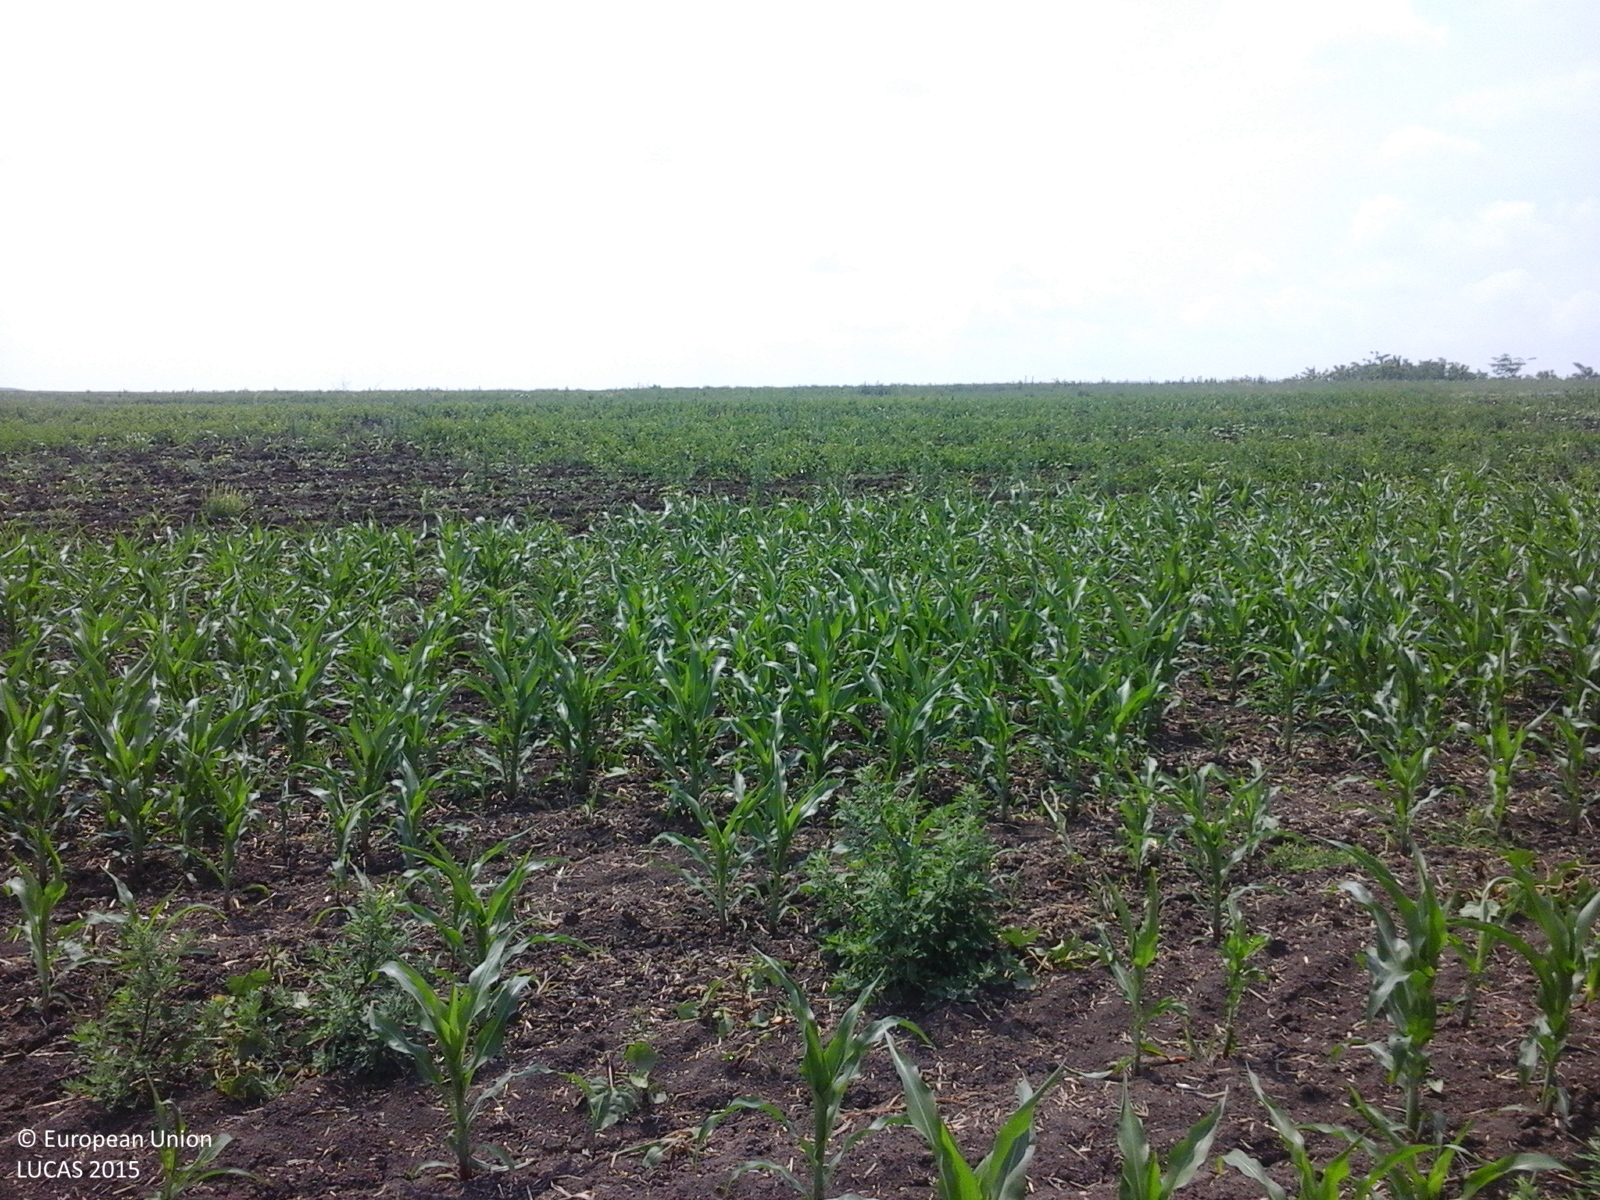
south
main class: Cropland
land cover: Maize
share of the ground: 10 - 25 %
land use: Agriculture (excluding fallow land and kitchen gardens)
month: June
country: RO
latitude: 47.3878
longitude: 26.9922
